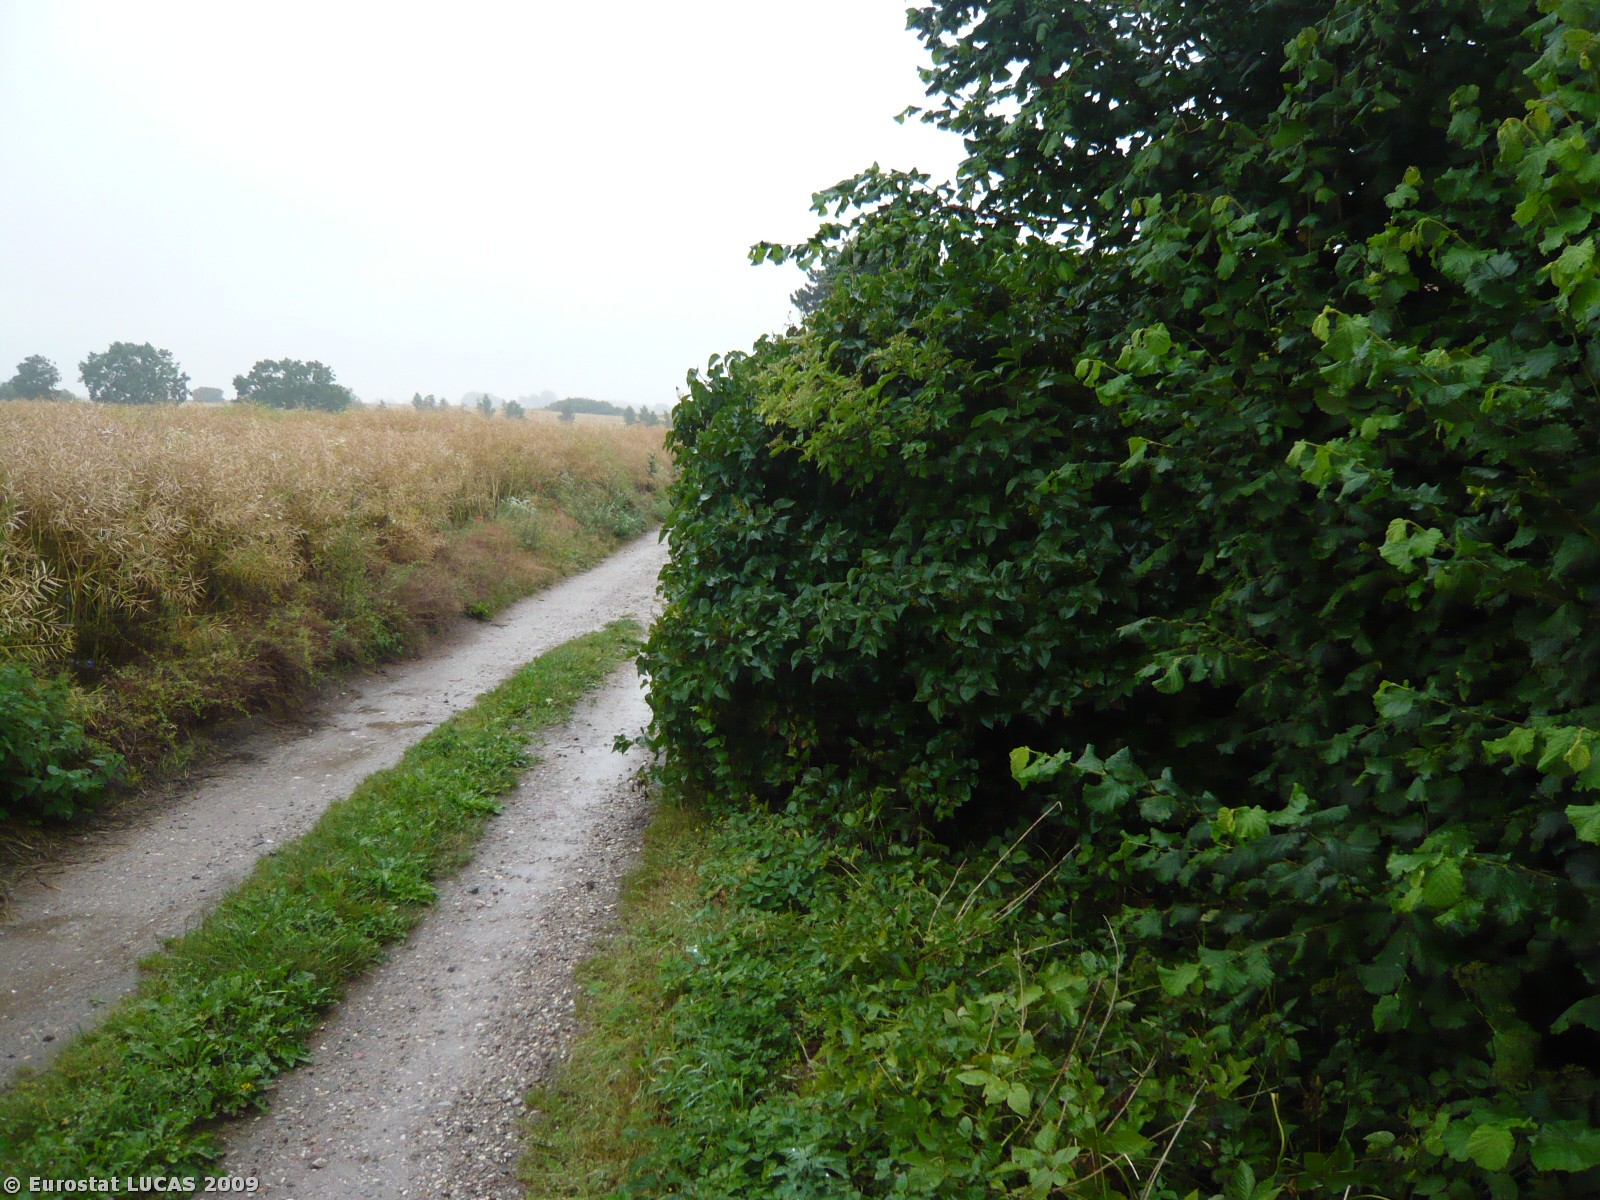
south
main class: Cropland
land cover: Rape and turnip rape
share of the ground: > 75 %
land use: Agriculture (excluding fallow land and kitchen gardens)
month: July
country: DK
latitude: 55.7787
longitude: 11.8637
